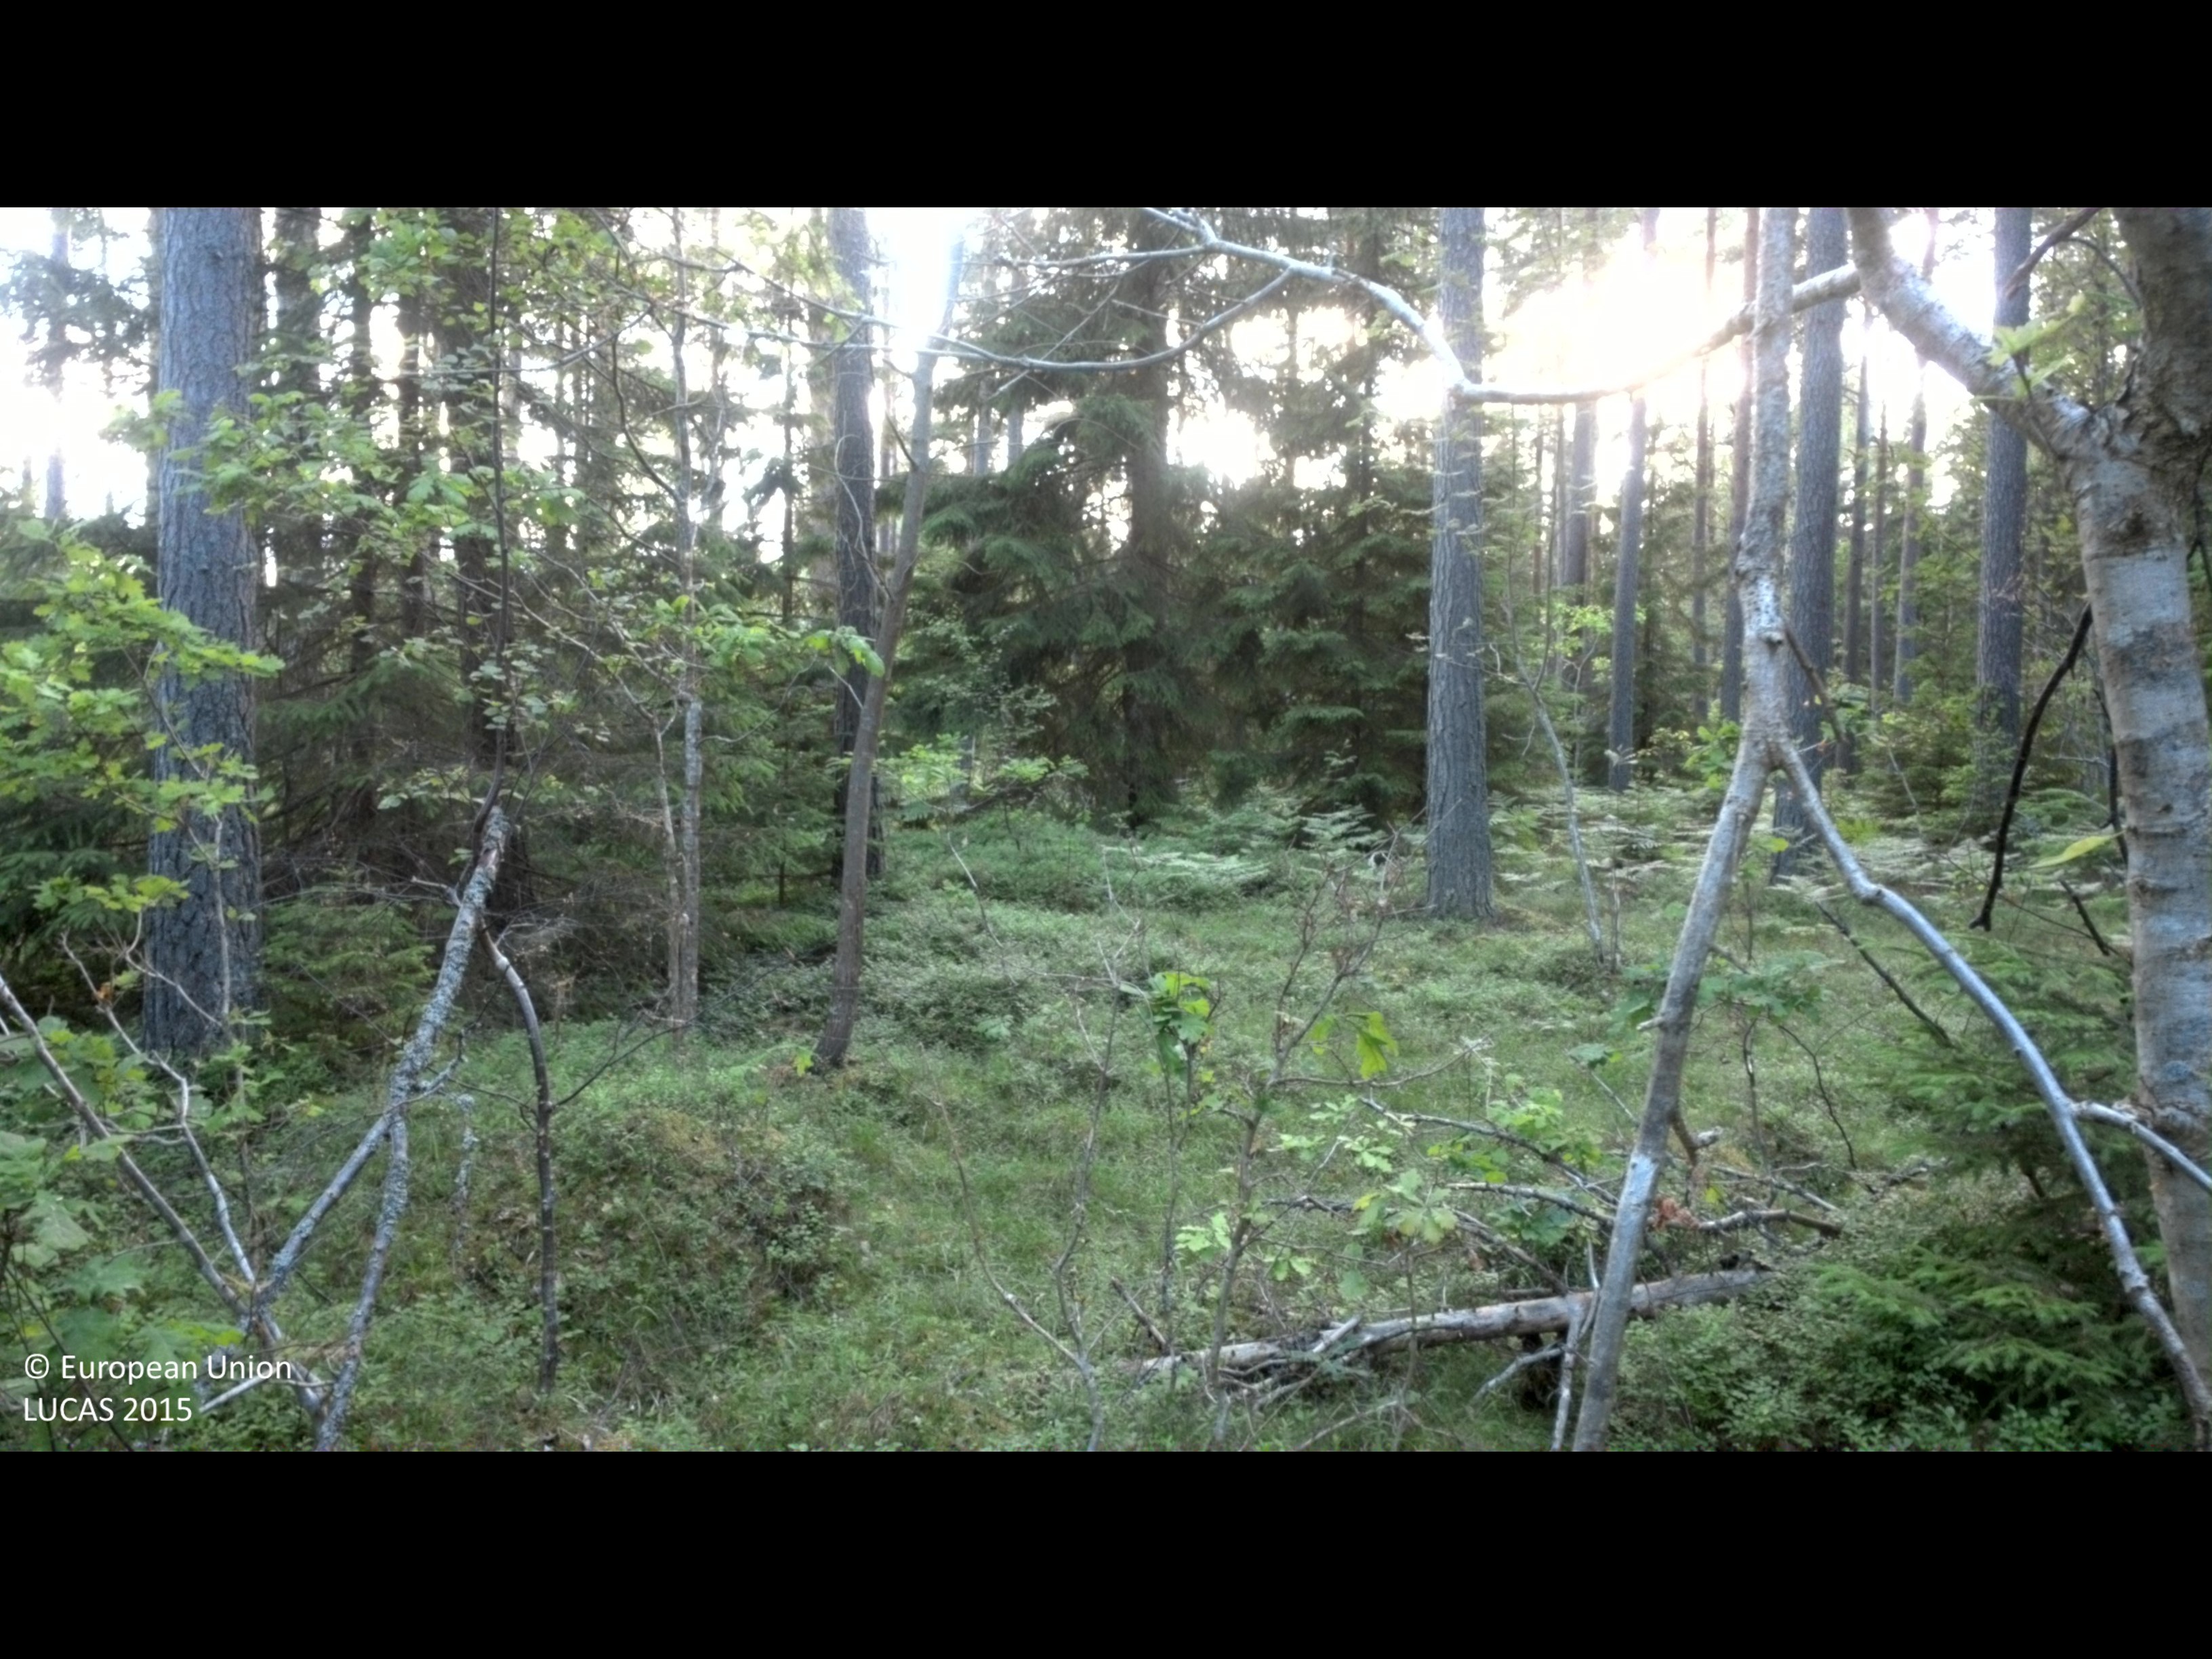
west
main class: Woodland
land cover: Pine dominated mixed woodland
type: hemiboreal forest and nemoral coniferous forest and mixed broadleaved-coniferous forest
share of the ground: > 75 %
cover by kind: coniferous forest trees 60 %, broadleaved forest trees 20 %, shrubs 15 %, herbaceous plants 5 %
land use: Forestry
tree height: > 5 m
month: June
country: SE
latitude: 57.8236
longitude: 16.5816
